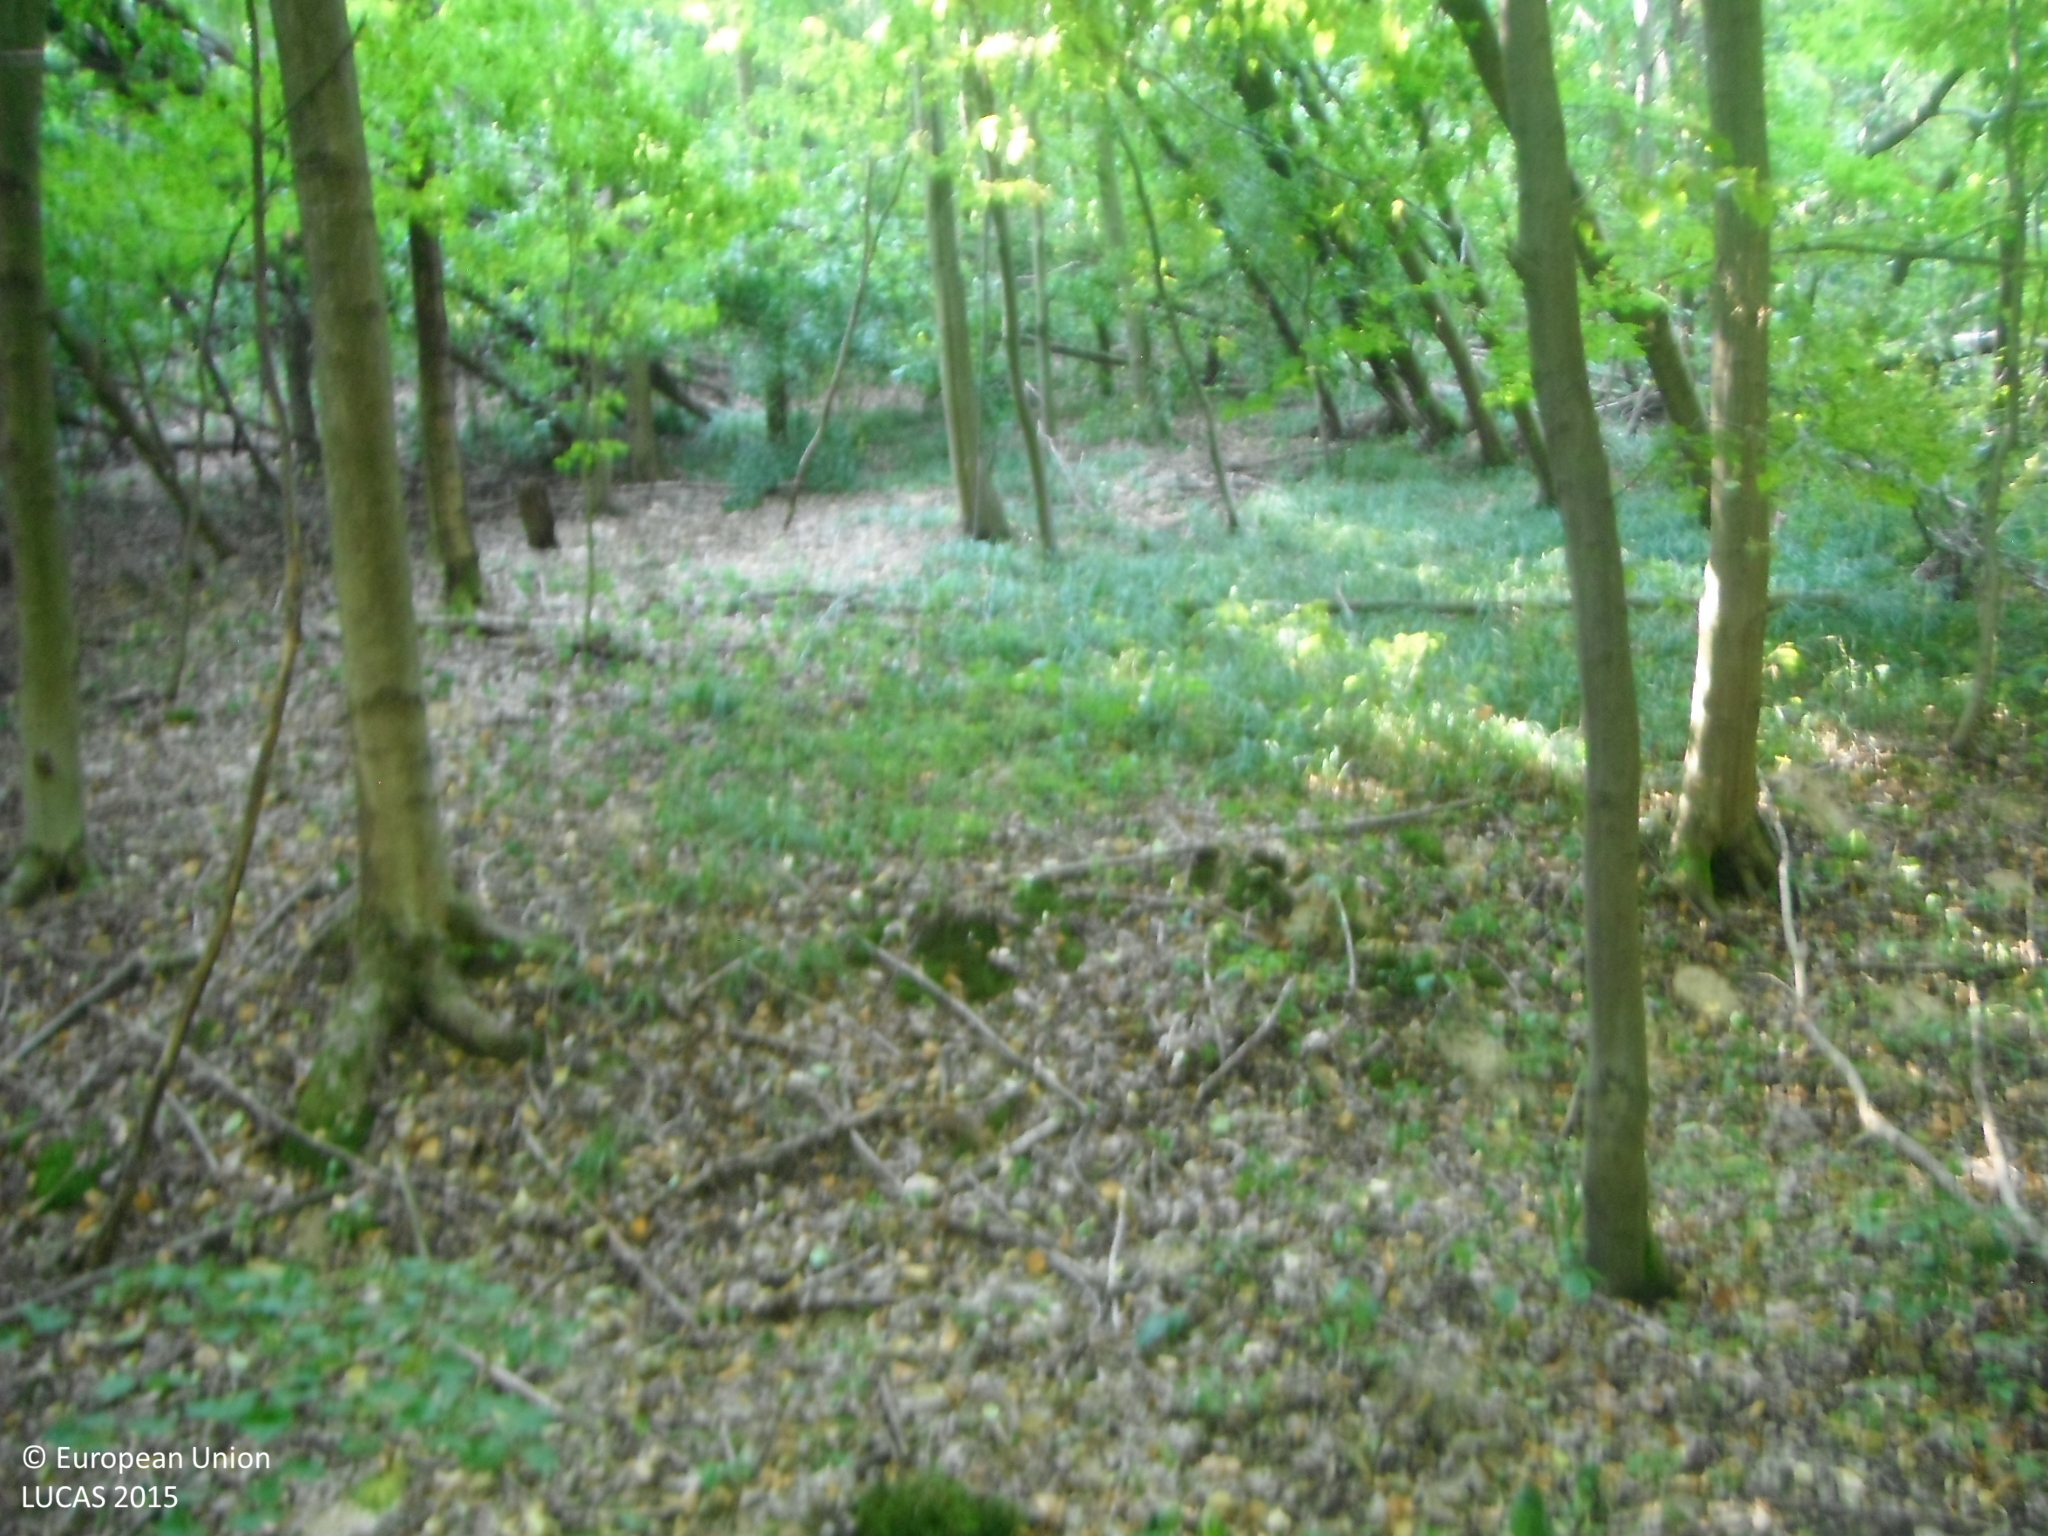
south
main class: Woodland
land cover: Broadleaved woodland
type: mesophytic deciduous forest
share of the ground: > 75 %
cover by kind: broadleaved forest trees 90 %, shrubs 5 %, unconsolidated bare surface 5 %
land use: Forestry
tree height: > 5 m
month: August
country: SK
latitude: 48.5934
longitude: 18.3546
